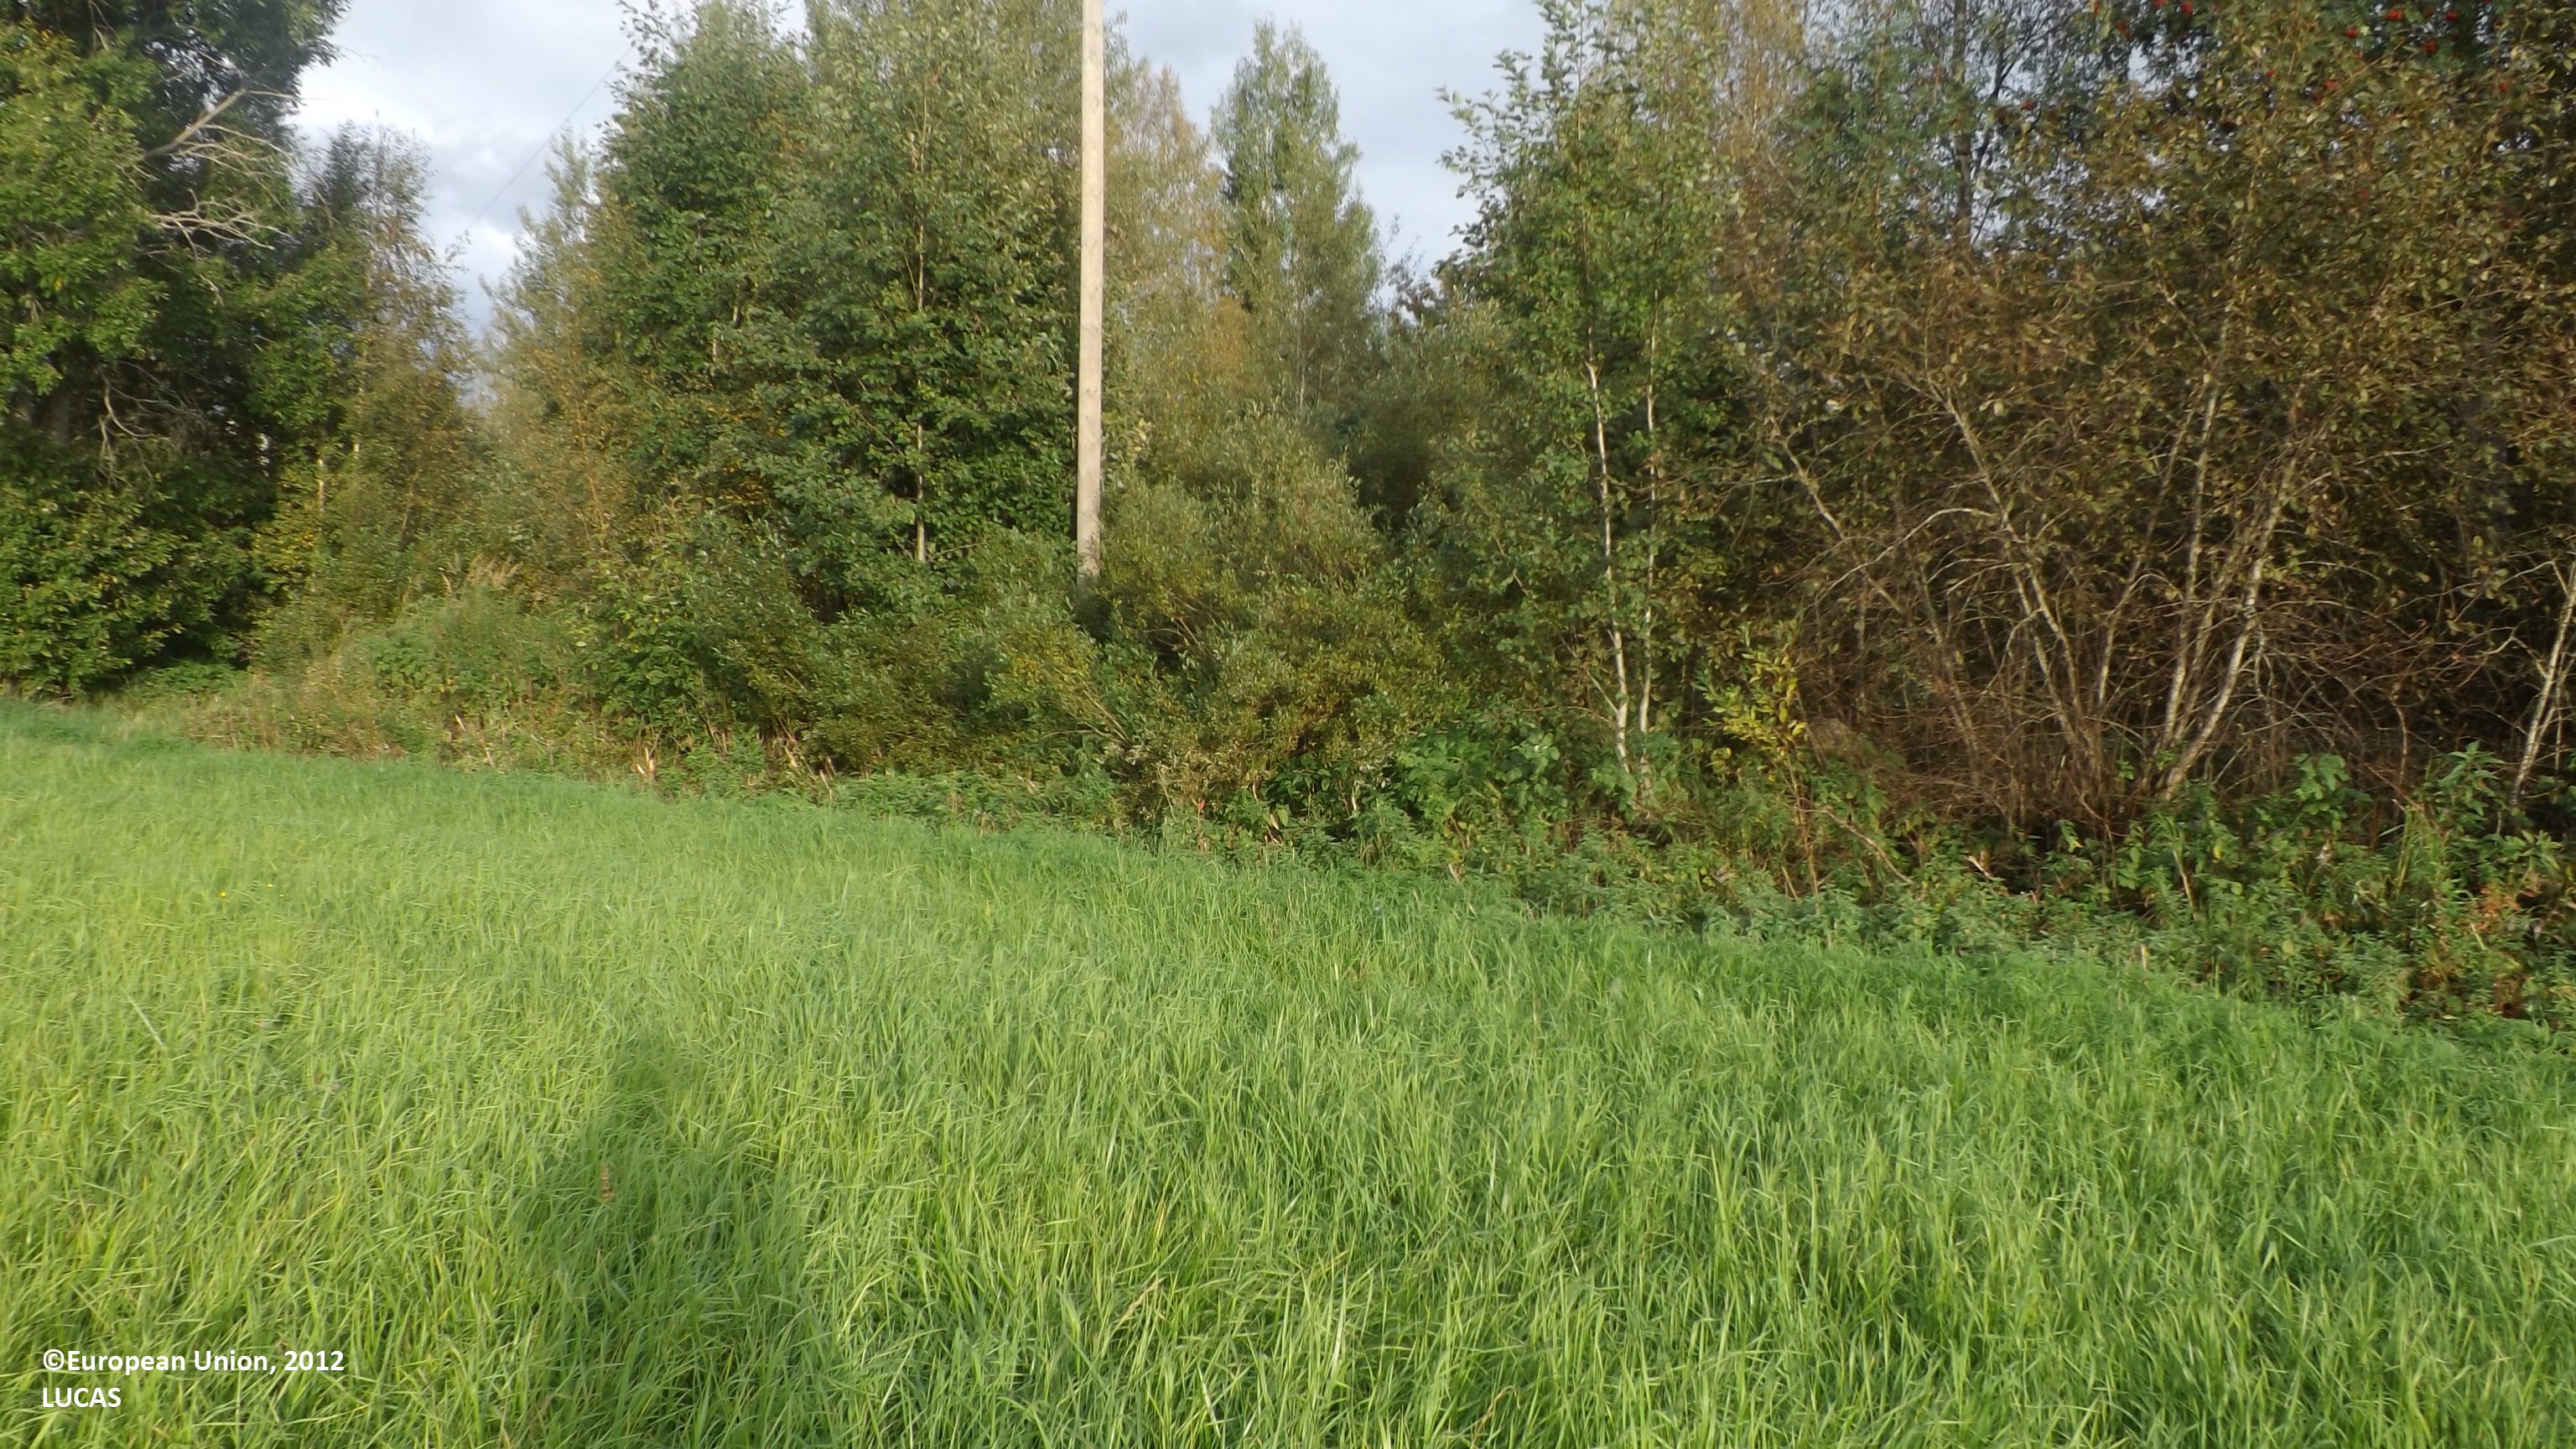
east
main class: Cropland
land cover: Temporary grasslands
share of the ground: > 75 %
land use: Agriculture (excluding fallow land and kitchen gardens)
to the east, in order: Temporary grasslands; Ditches and canals; Broadleaved woodland; Electric lines; Grassland with sparse tree/shrub cover; Broadleaved woodland; Shrubland with sparse tree cover; Spruce dominated mixed woodland; Grassland with sparse tree/shrub cover; Electric lines; Broadleaved woodland; Ditches and canals; Temporary grasslands; Ditches and canals; Broadleaved woodland; Ditches and canals; Temporary grasslands; Ditches and canals; Temporary grasslands; Ditches and canals; Grassland without tree/shrub cover; Ditches and canals; Other mixed woodland
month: August
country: FI
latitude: 63.8119
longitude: 23.3594
